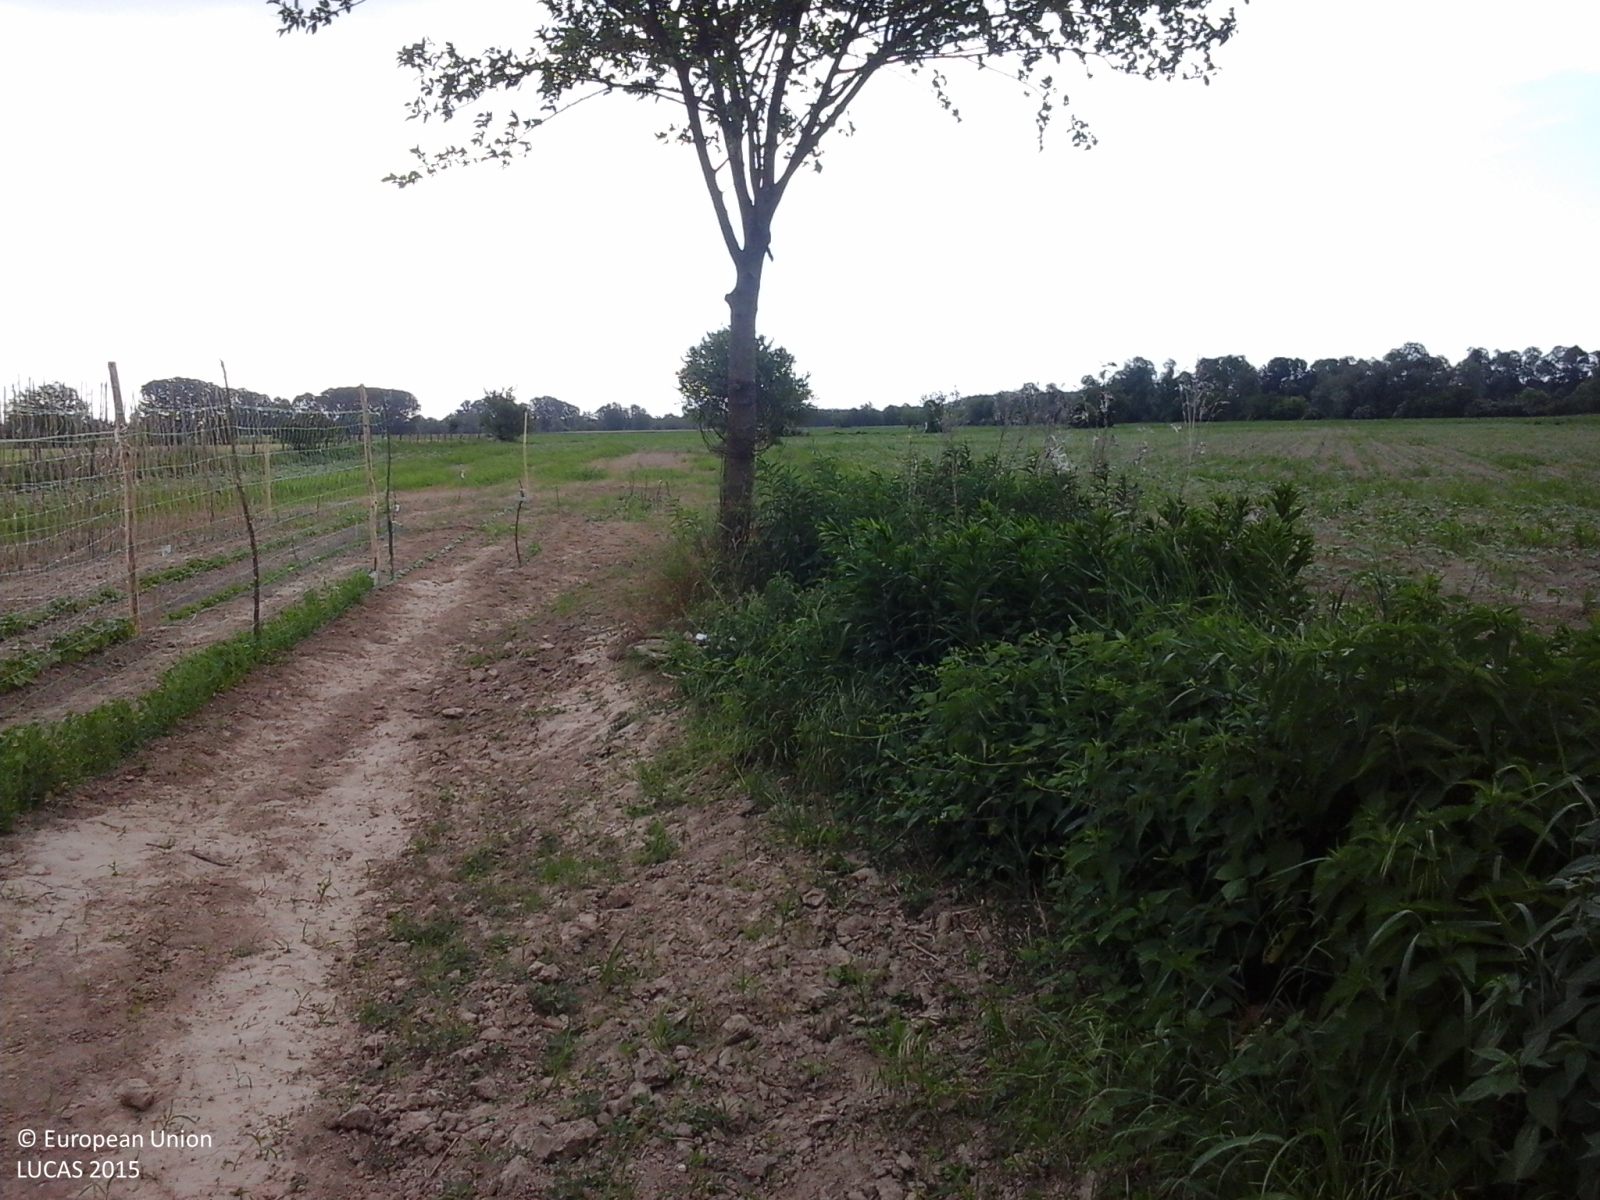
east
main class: Cropland
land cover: Other fresh vegetables
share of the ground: < 10 %
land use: Kitchen garden
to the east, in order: Other fresh vegetables; Sunflower; Ditches and canals; Maize
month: May
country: IT
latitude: 44.8796
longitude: 8.4207
